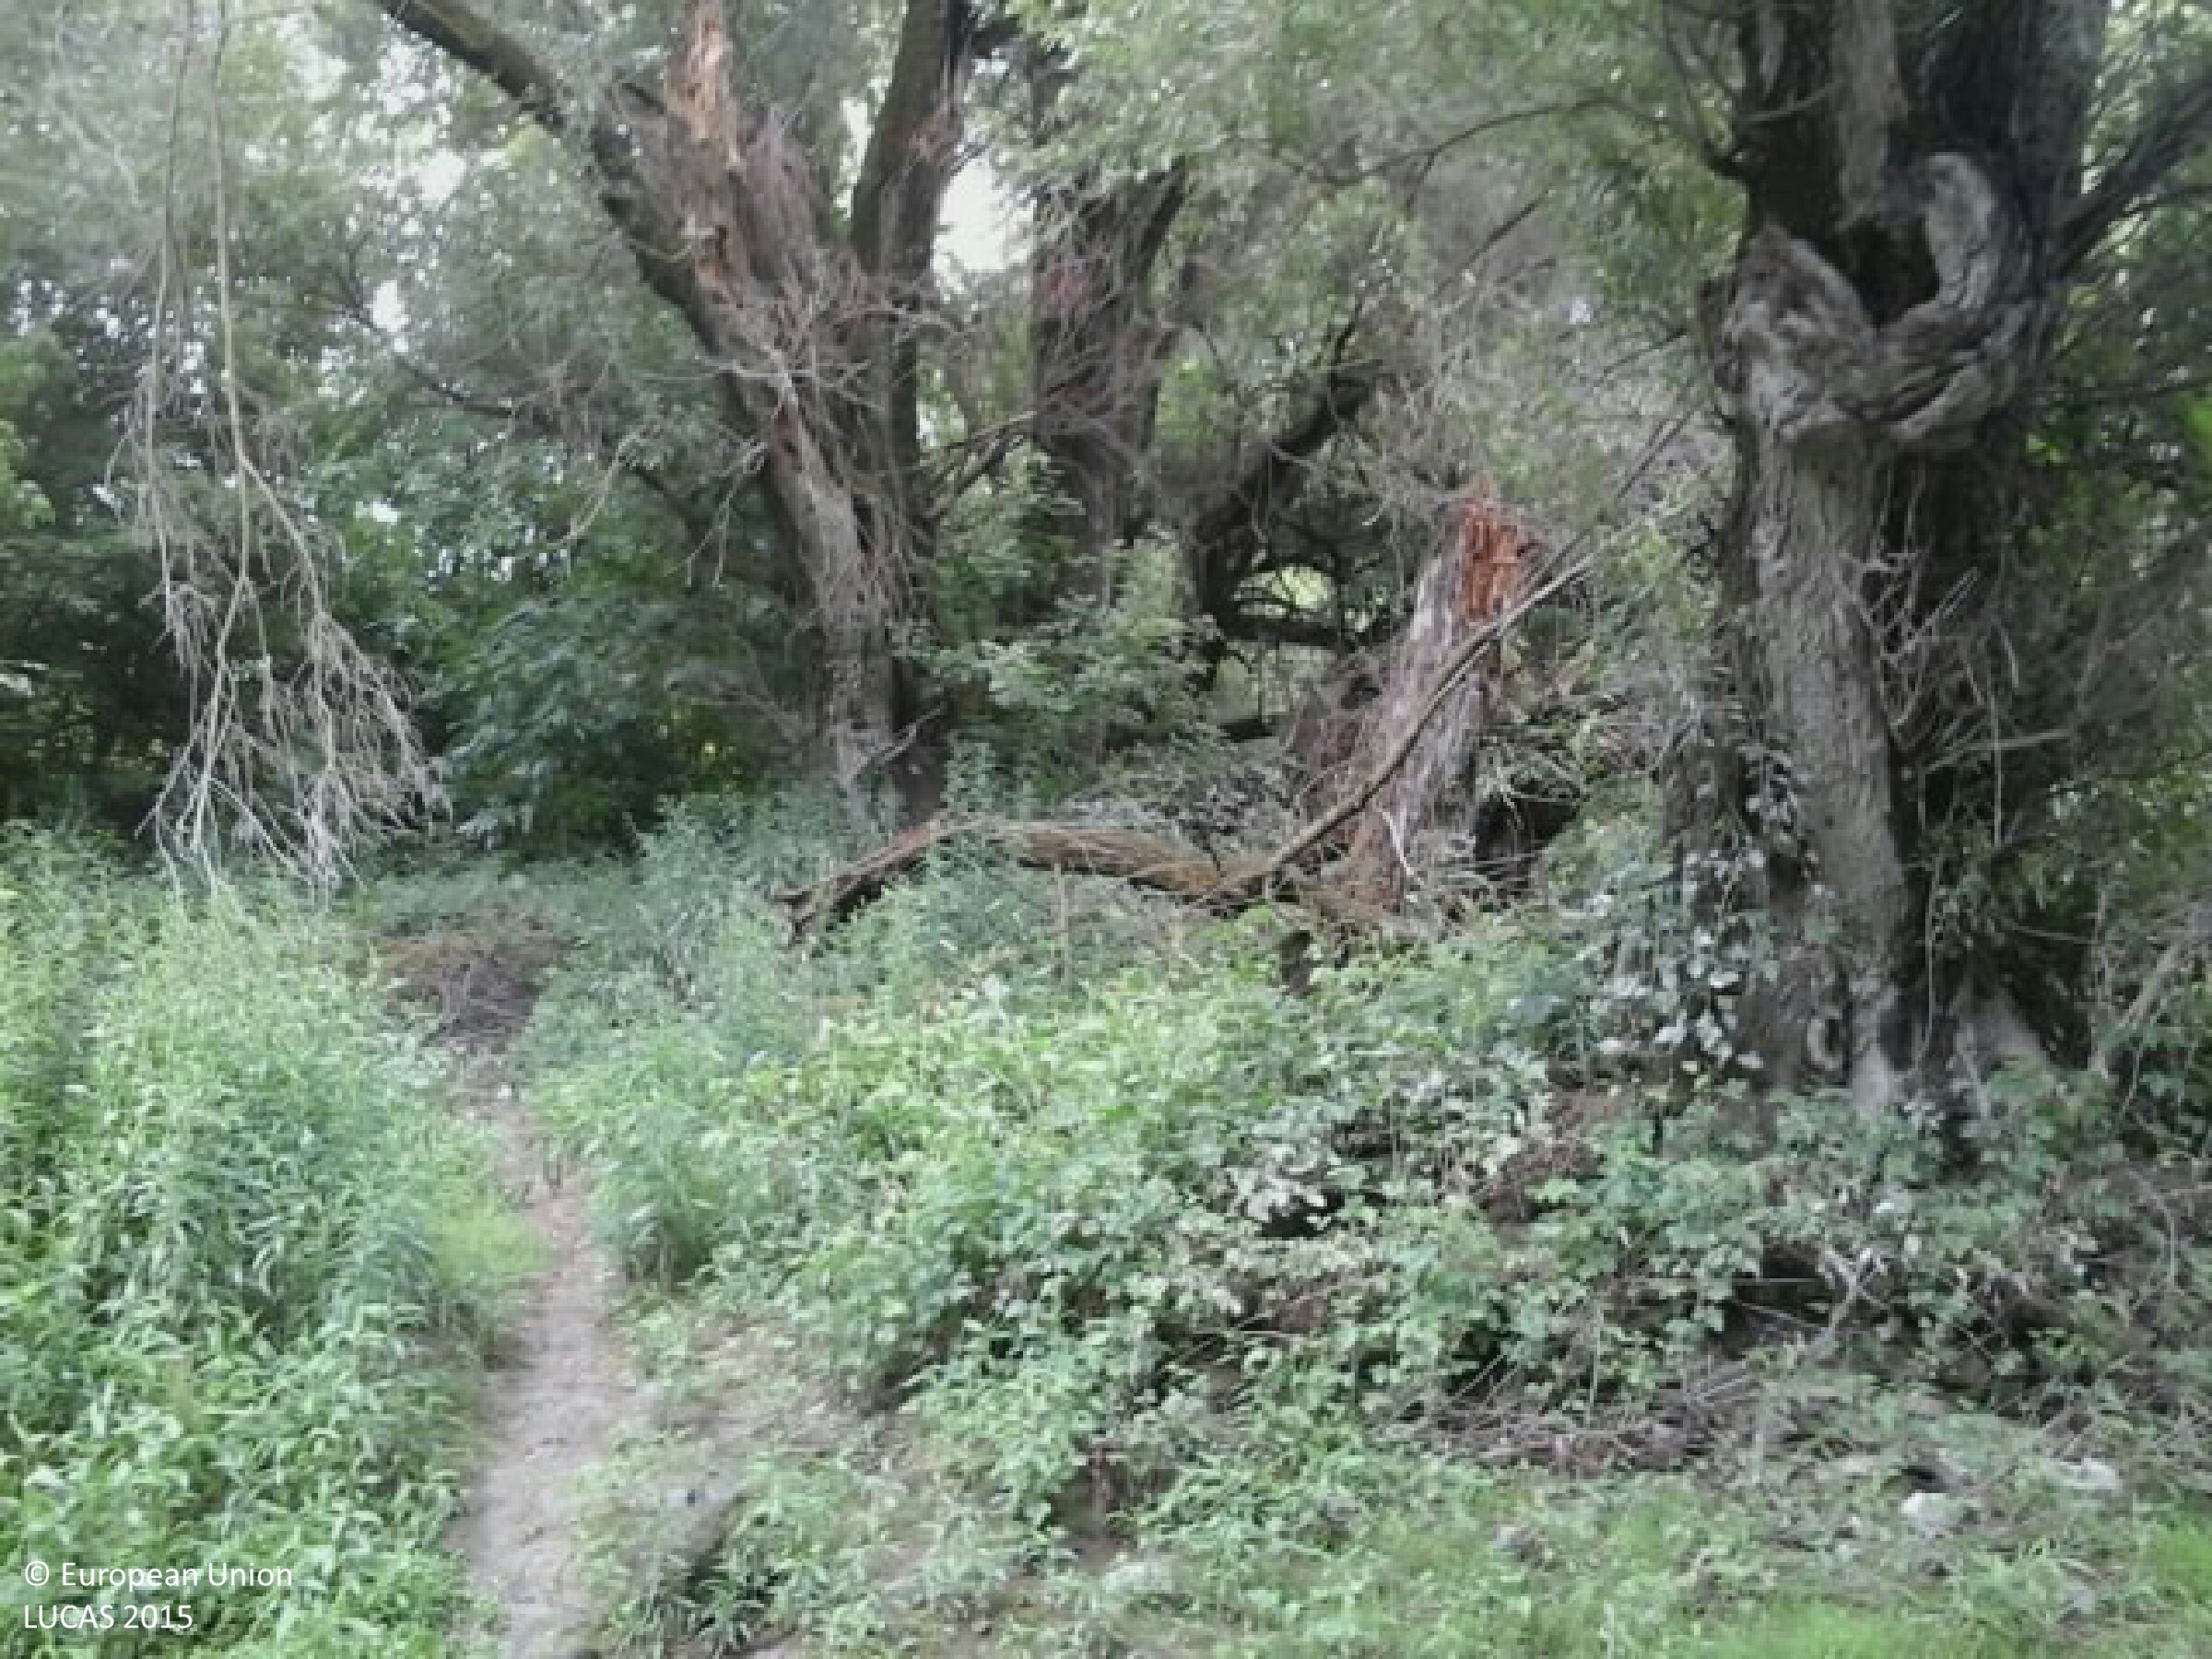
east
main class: Woodland
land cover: Broadleaved woodland
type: mesophytic deciduous forest
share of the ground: 50 - 75 %
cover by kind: broadleaved forest trees 60 %, shrubs 15 %, herbaceous plants 15 %, unconsolidated bare surface 10 %
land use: Forestry
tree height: > 5 m
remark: Temporary dry
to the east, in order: Broadleaved woodland; Grassland without tree/shrub cover; Broadleaved woodland; Inland fresh running water; Broadleaved woodland
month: July
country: HU
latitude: 46.4860
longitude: 18.9103
